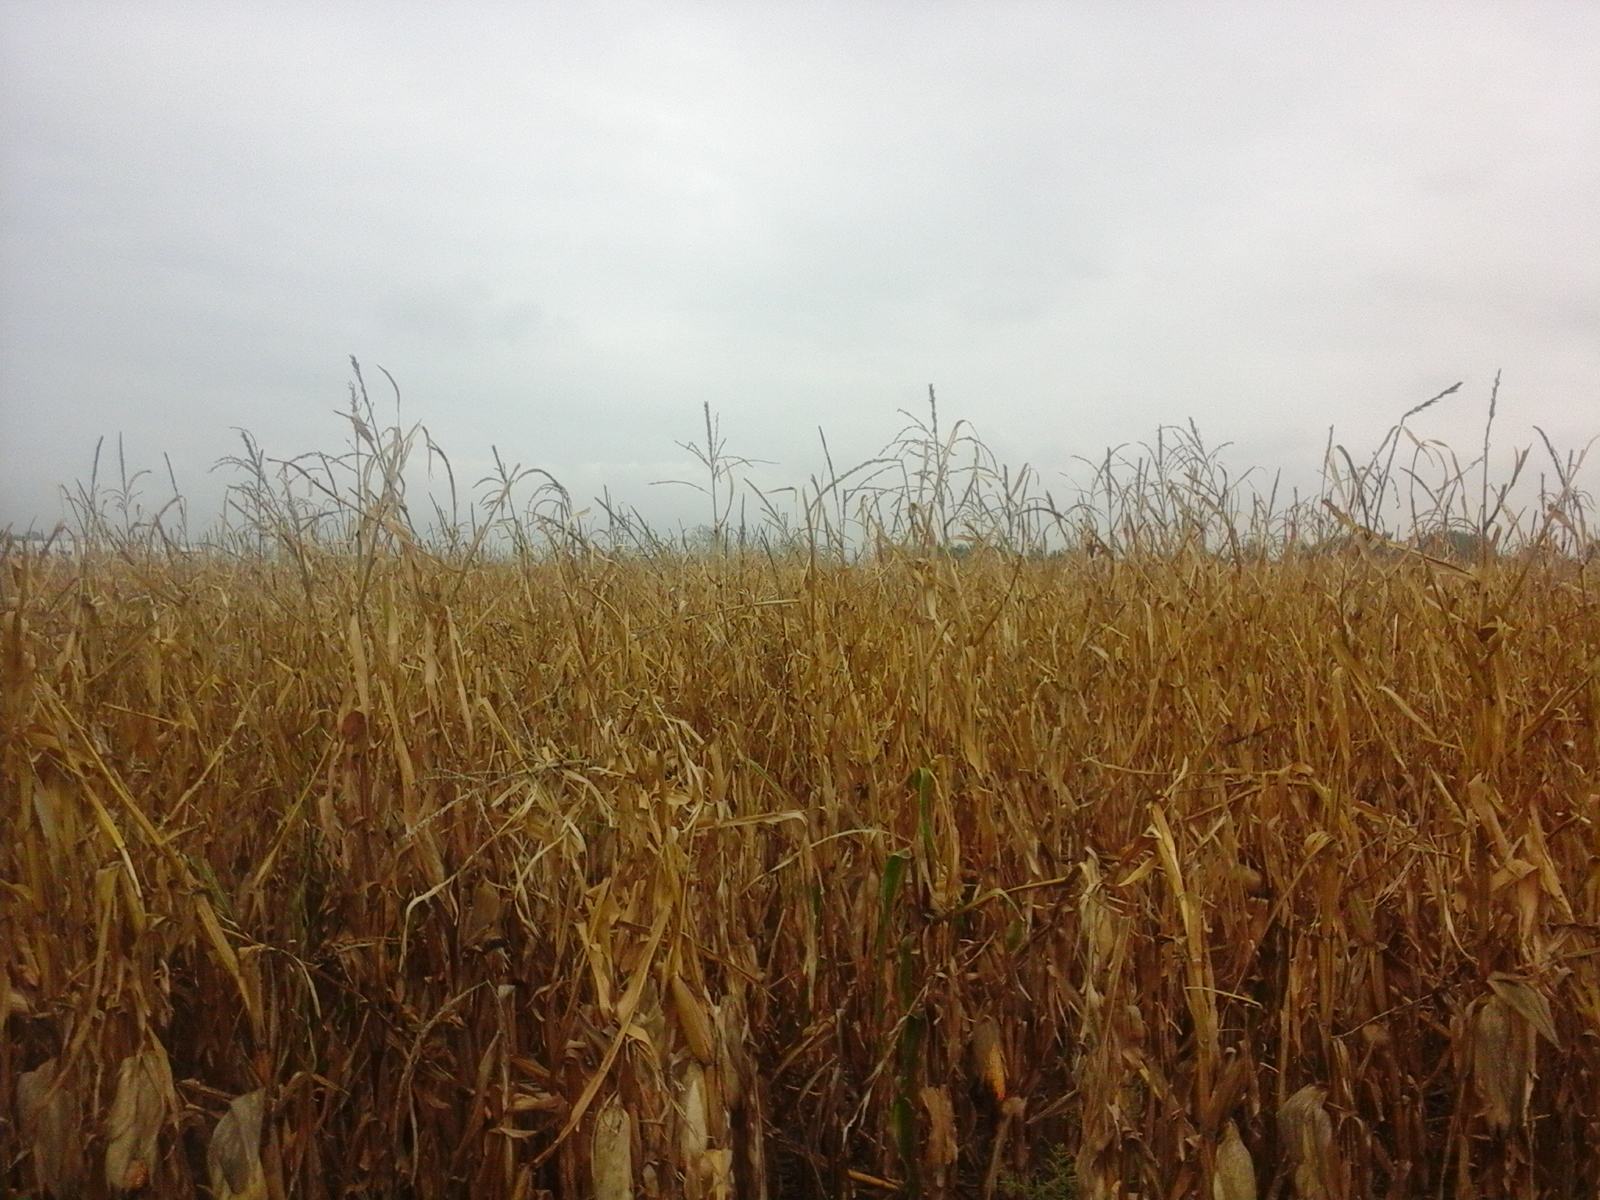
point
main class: Cropland
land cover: Maize
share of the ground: > 75 %
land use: Agriculture (excluding fallow land and kitchen gardens)
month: September
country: RO
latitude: 47.1101
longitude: 21.8399
